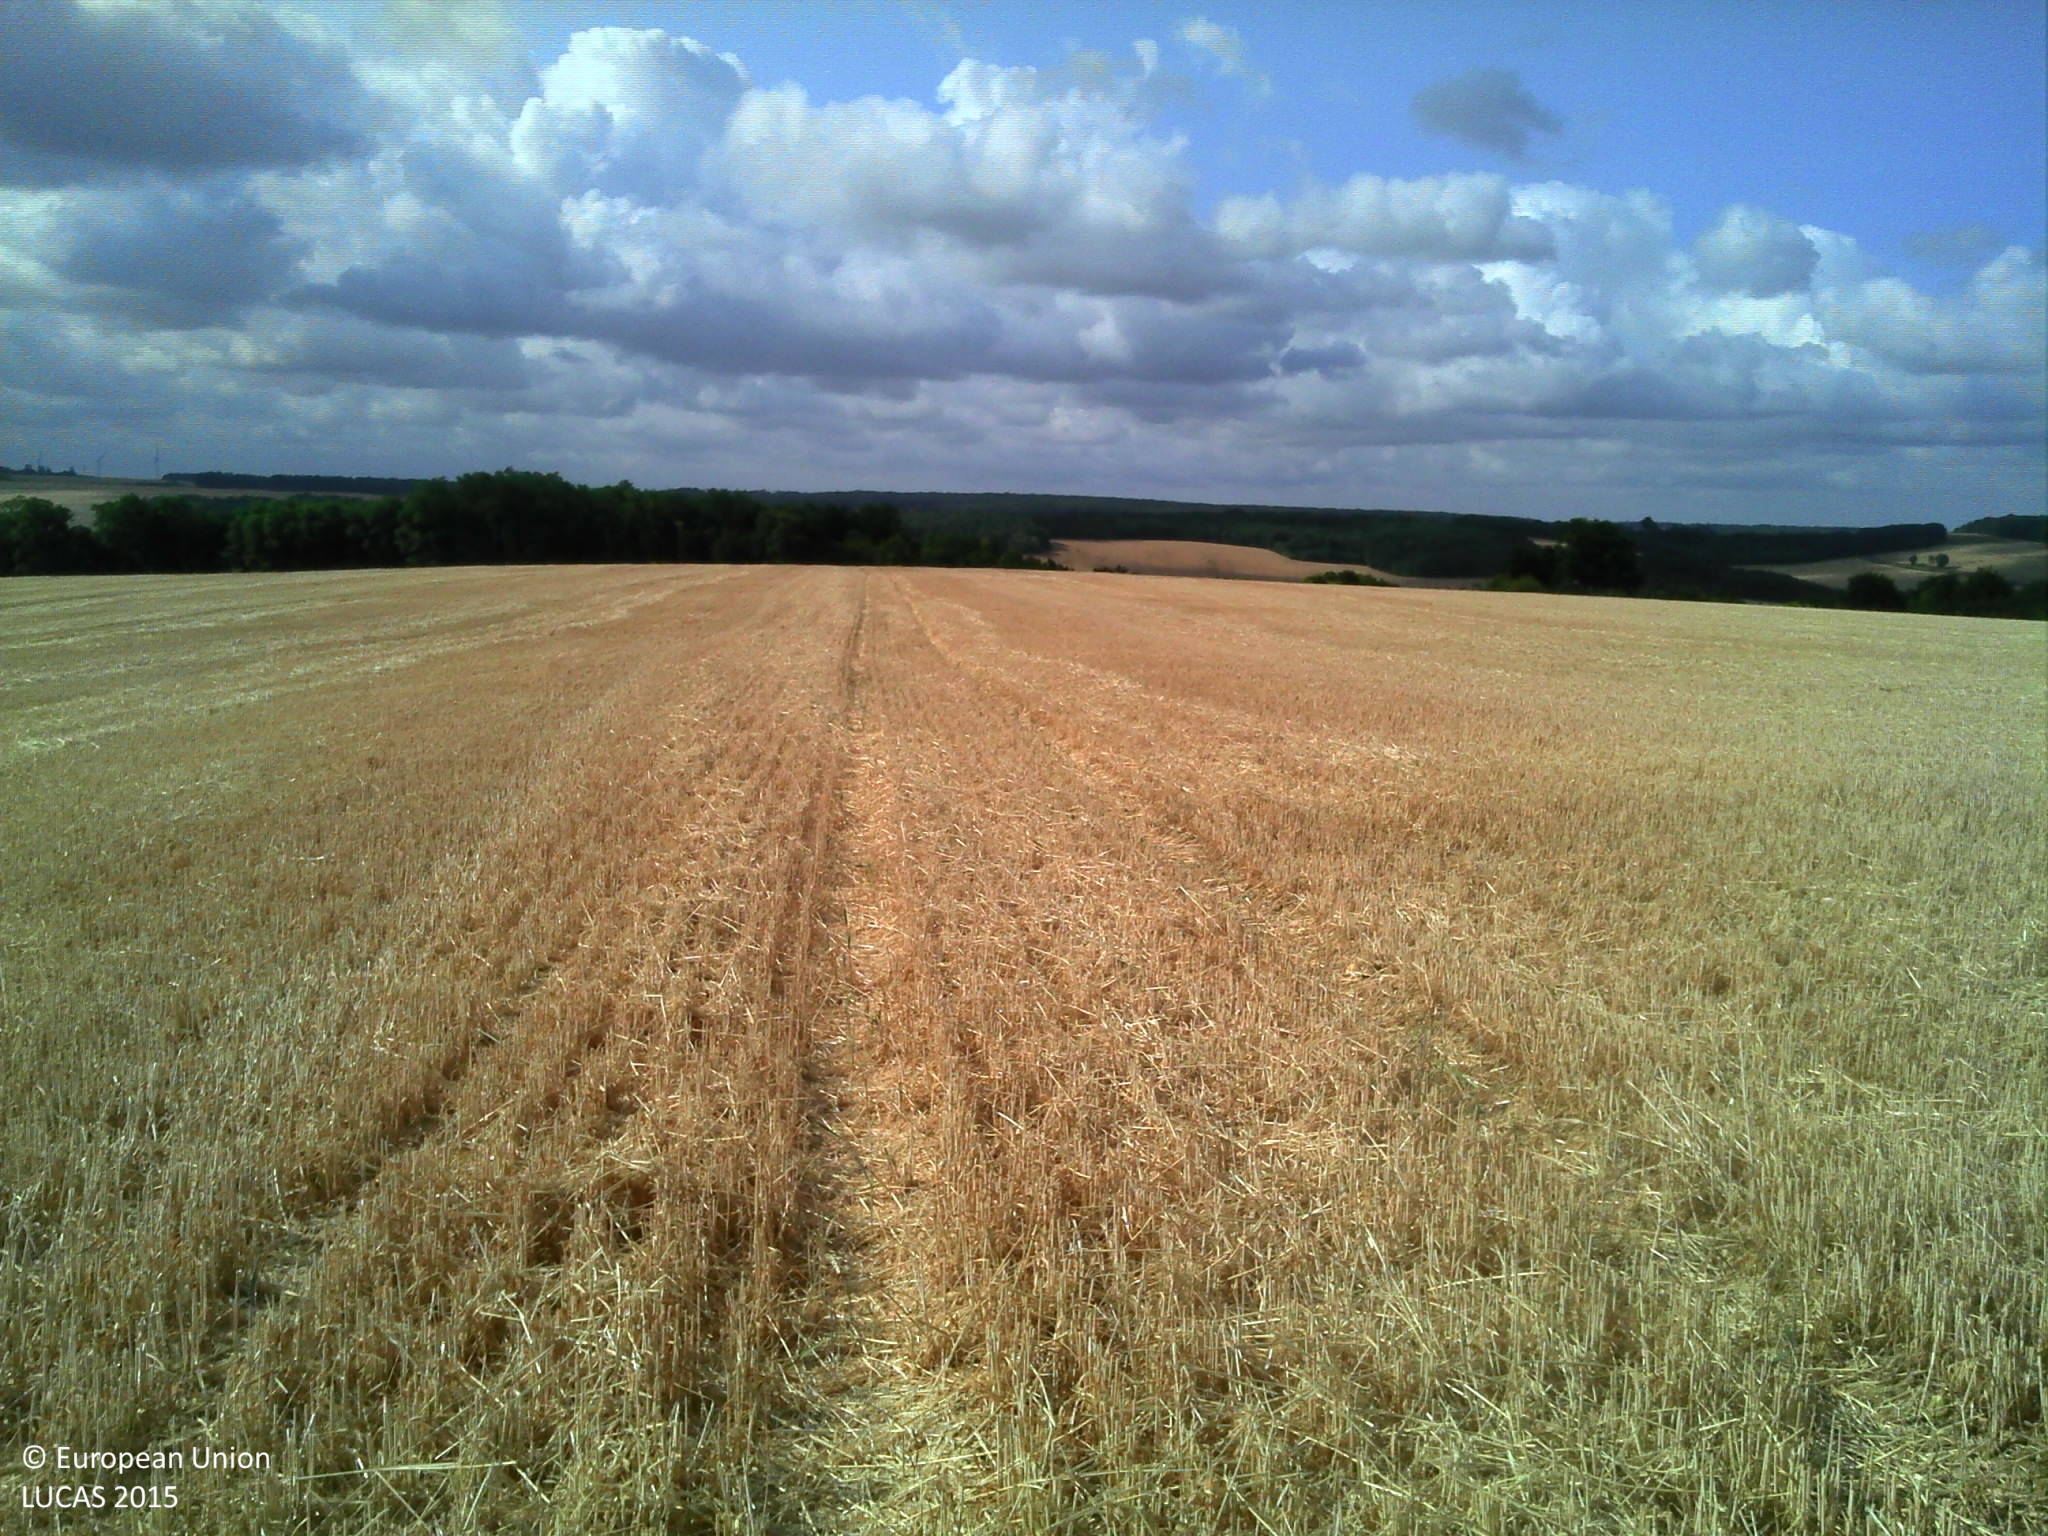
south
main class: Cropland
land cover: Common wheat
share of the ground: > 75 %
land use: Agriculture (excluding fallow land and kitchen gardens)
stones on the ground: 10 - 25 %
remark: Harvested field
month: July
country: FR
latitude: 48.2608
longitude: 3.4070
